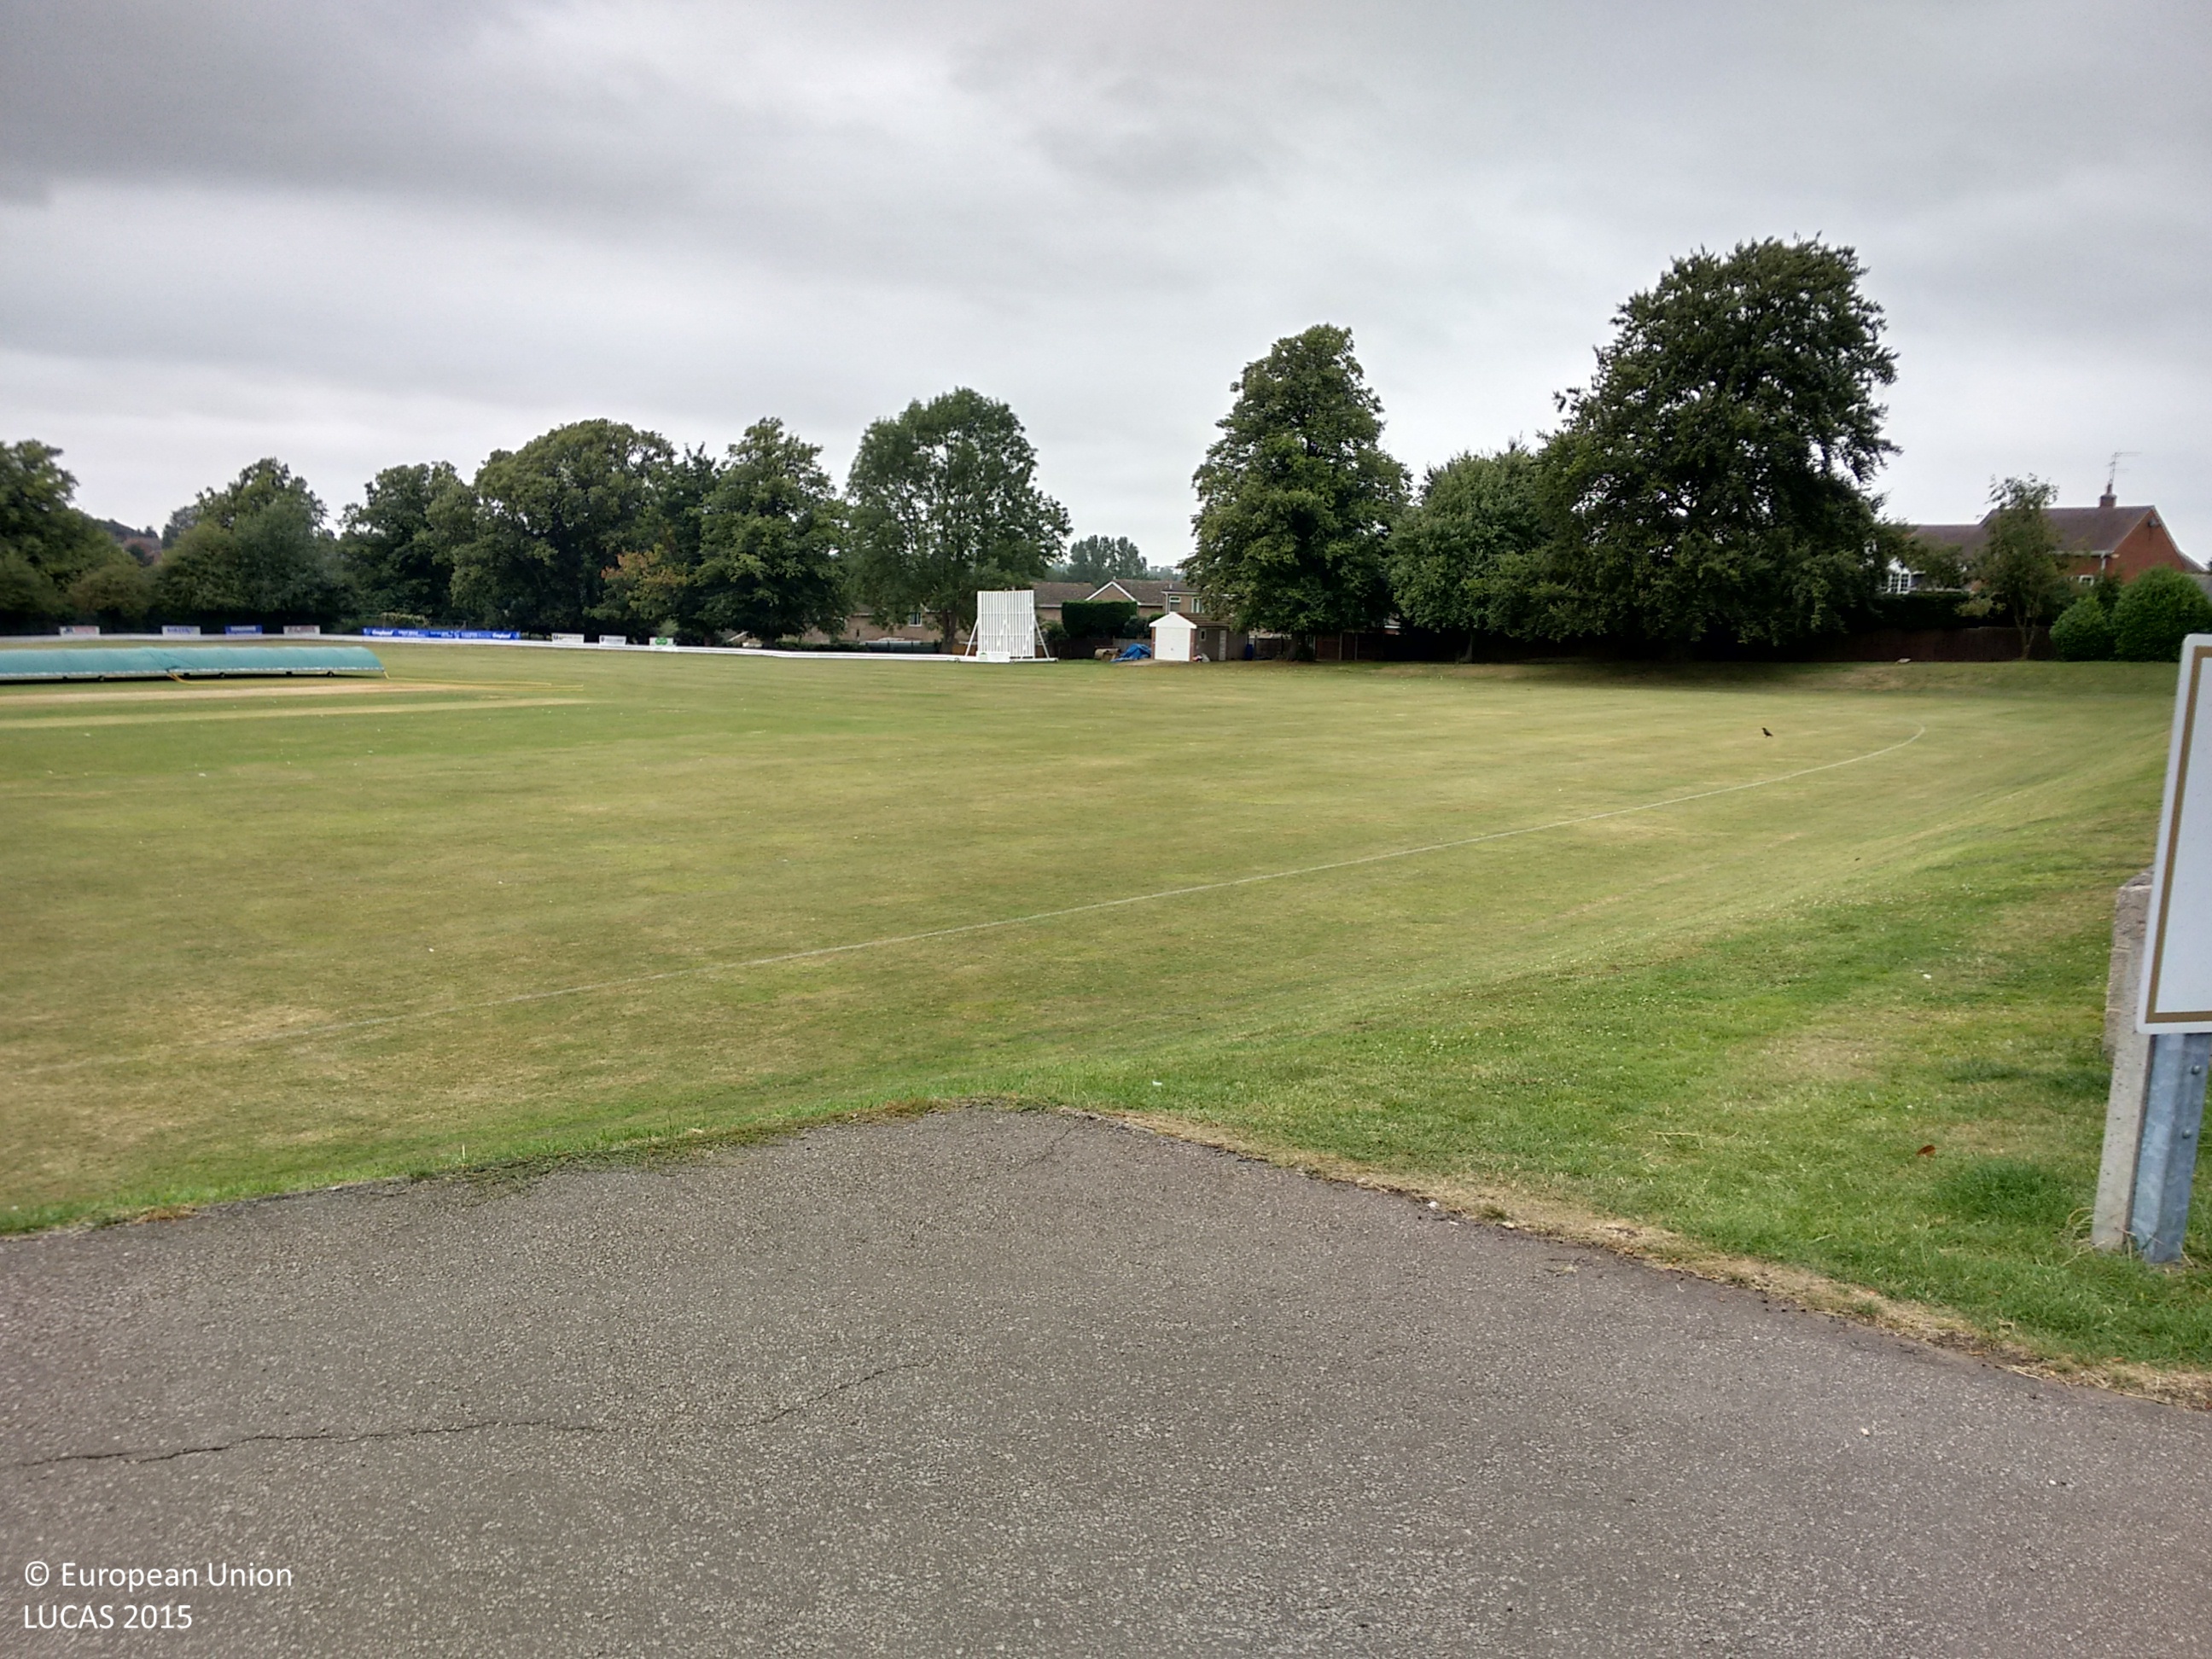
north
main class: Grassland
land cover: Grassland without tree/shrub cover
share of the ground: > 75 %
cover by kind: herbaceous plants 100 %
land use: Sport
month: August
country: GB
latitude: 52.3093
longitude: -0.7037
